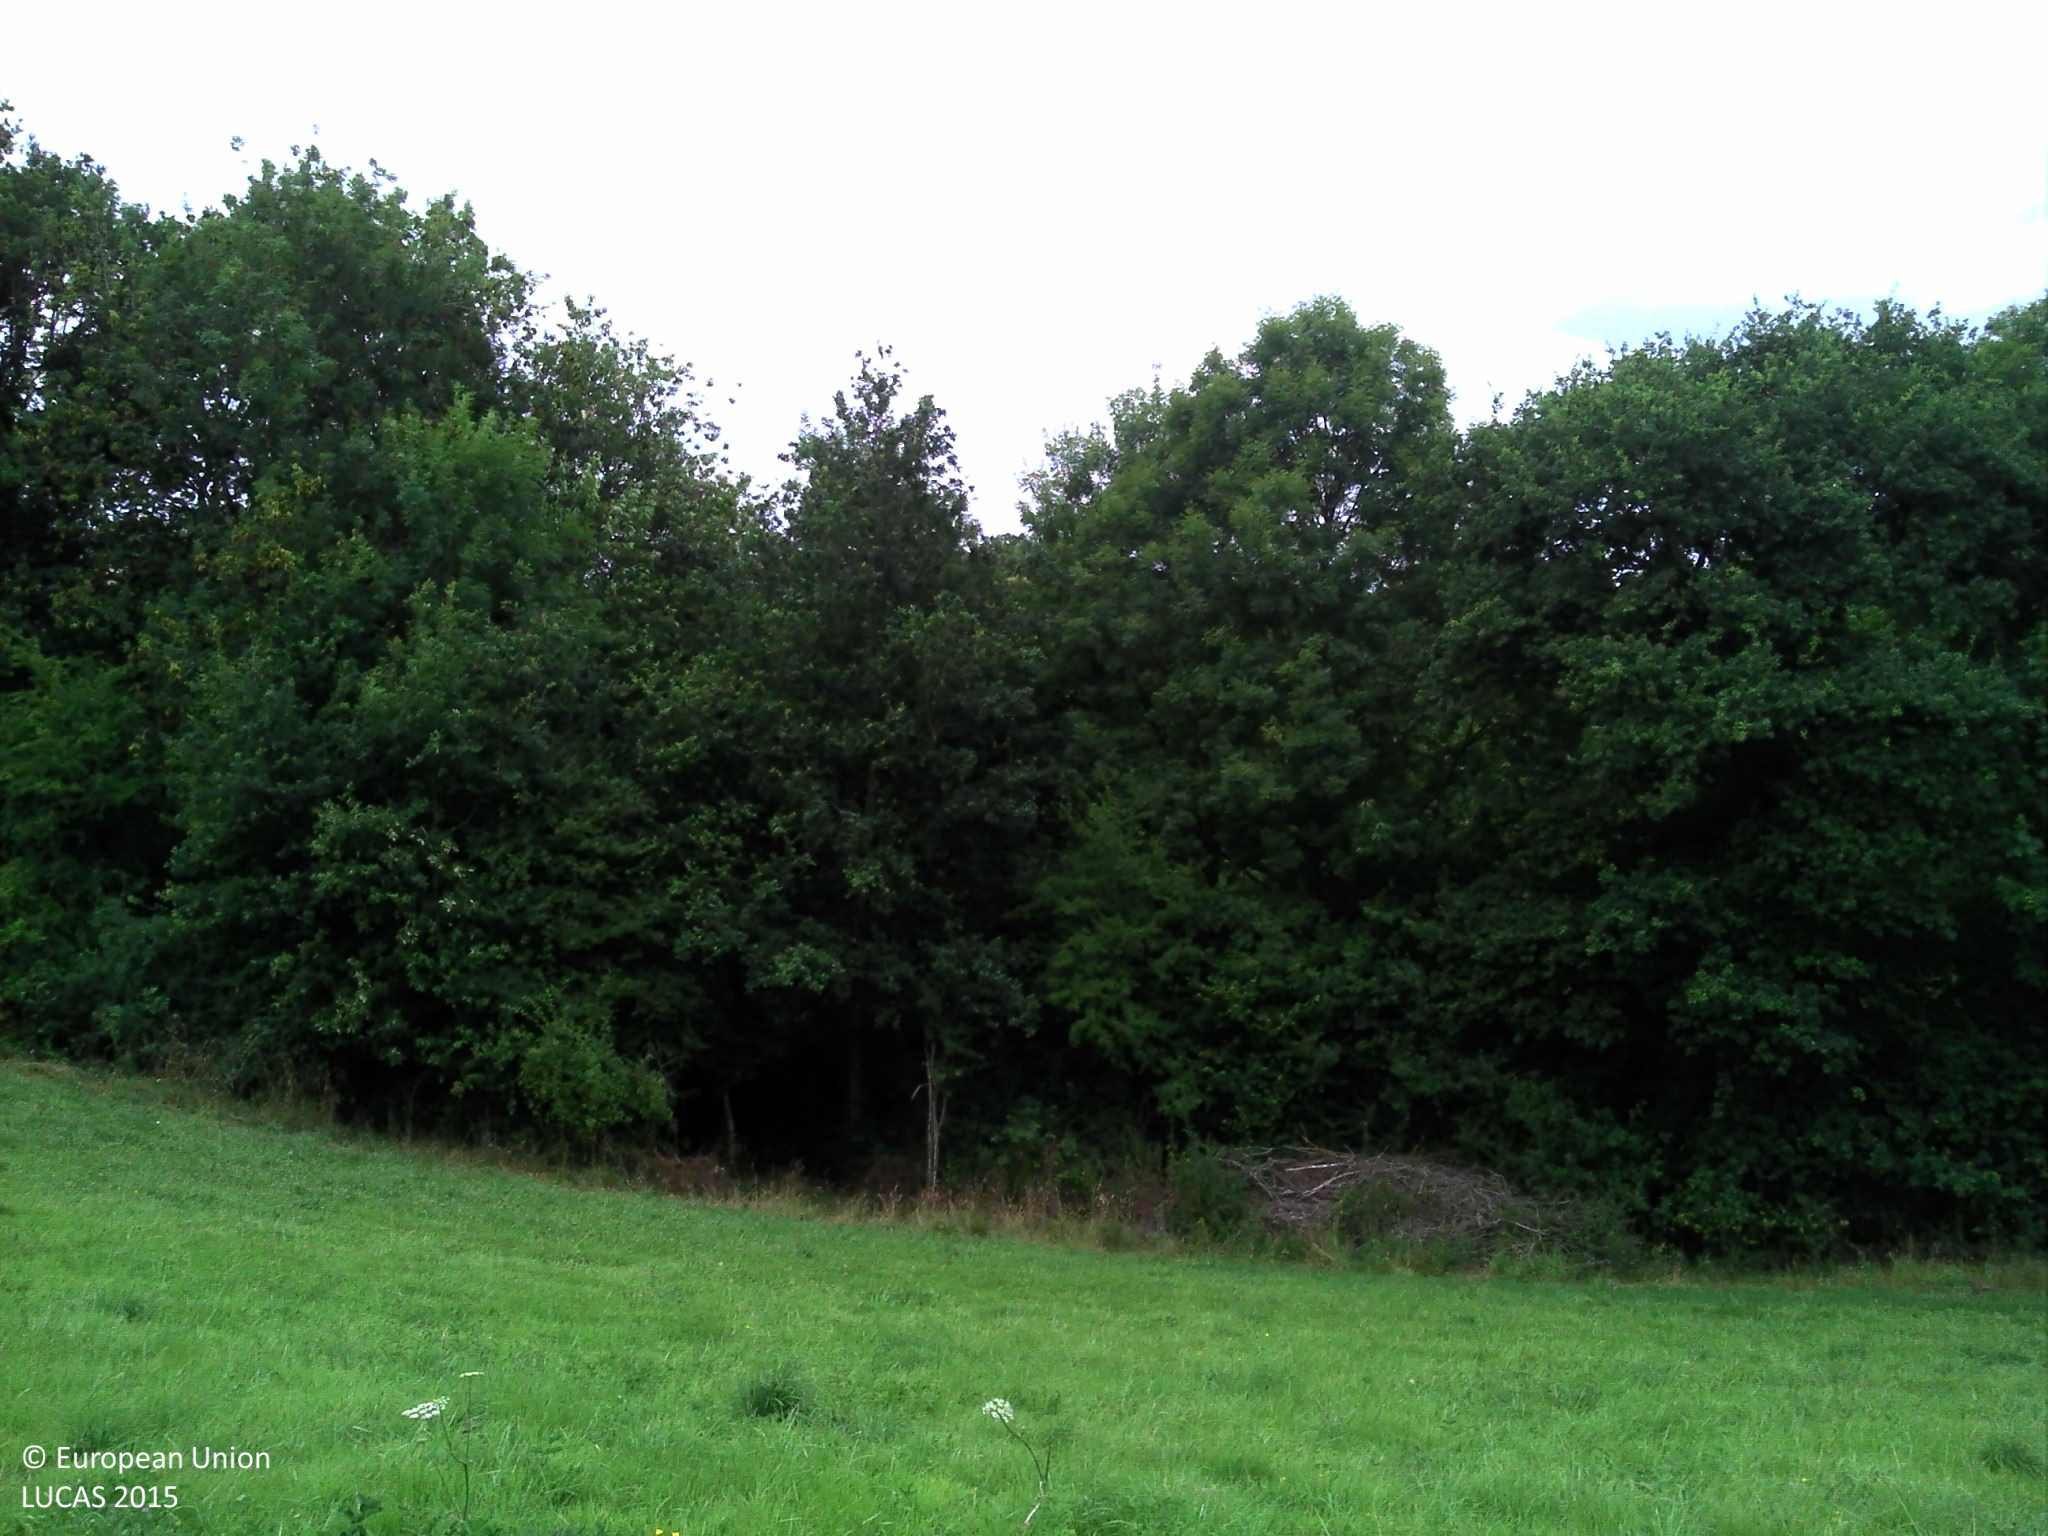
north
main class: Grassland
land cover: Grassland without tree/shrub cover
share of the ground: > 75 %
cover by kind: herbaceous plants 100 %
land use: Agriculture (excluding fallow land and kitchen gardens)
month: July
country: FR
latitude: 48.3736
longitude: -0.1150
